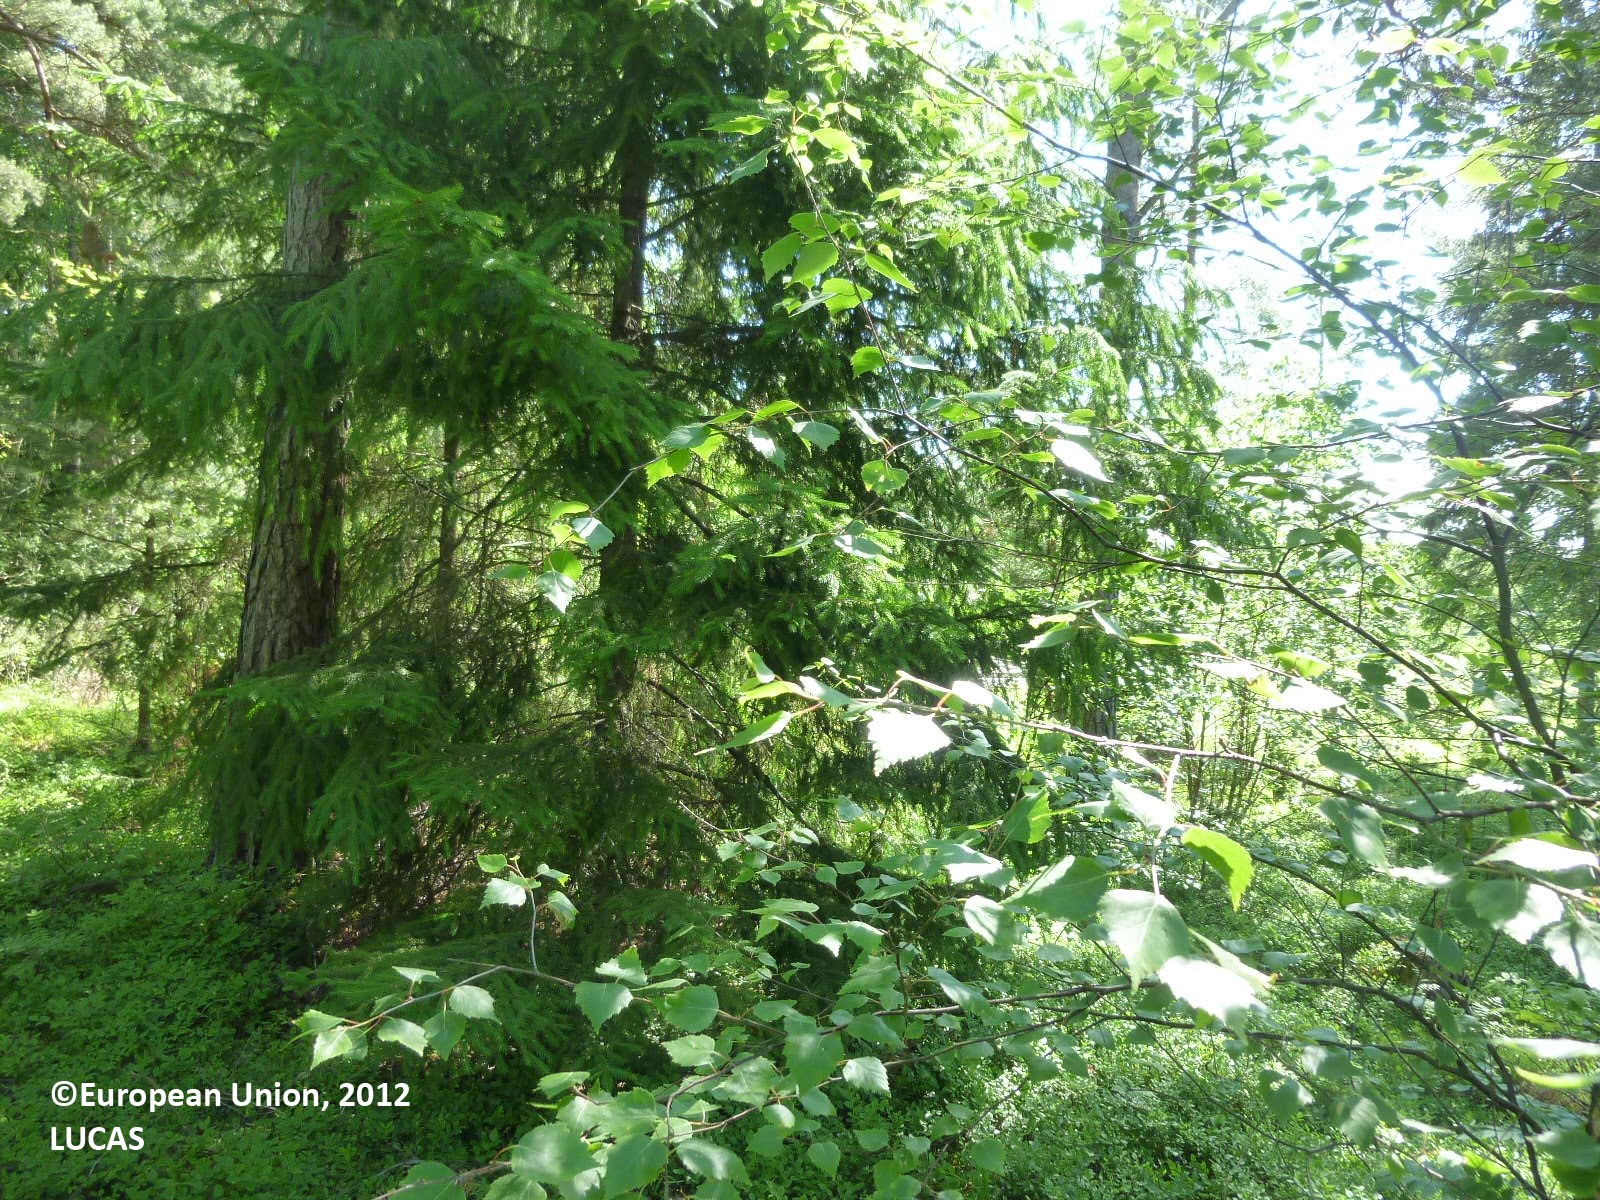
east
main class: Woodland
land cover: Other coniferous woodland
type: boreal forest
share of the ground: 25 - 50 %
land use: Forestry
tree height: > 5 m
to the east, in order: Other coniferous woodland; Pine dominated coniferous woodland; Grassland without tree/shrub cover; Shrubland without tree cover; Broadleaved woodland; Ditches and canals; Broadleaved woodland; Shrubland with sparse tree cover; Ditches and canals; Broadleaved woodland; Ditches and canals; Pine dominated coniferous woodland; Grassland without tree/shrub cover; Electric lines; Grassland without tree/shrub cover; Pine dominated mixed woodland; Broadleaved woodland
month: June
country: FI
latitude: 60.2091
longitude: 22.4679
